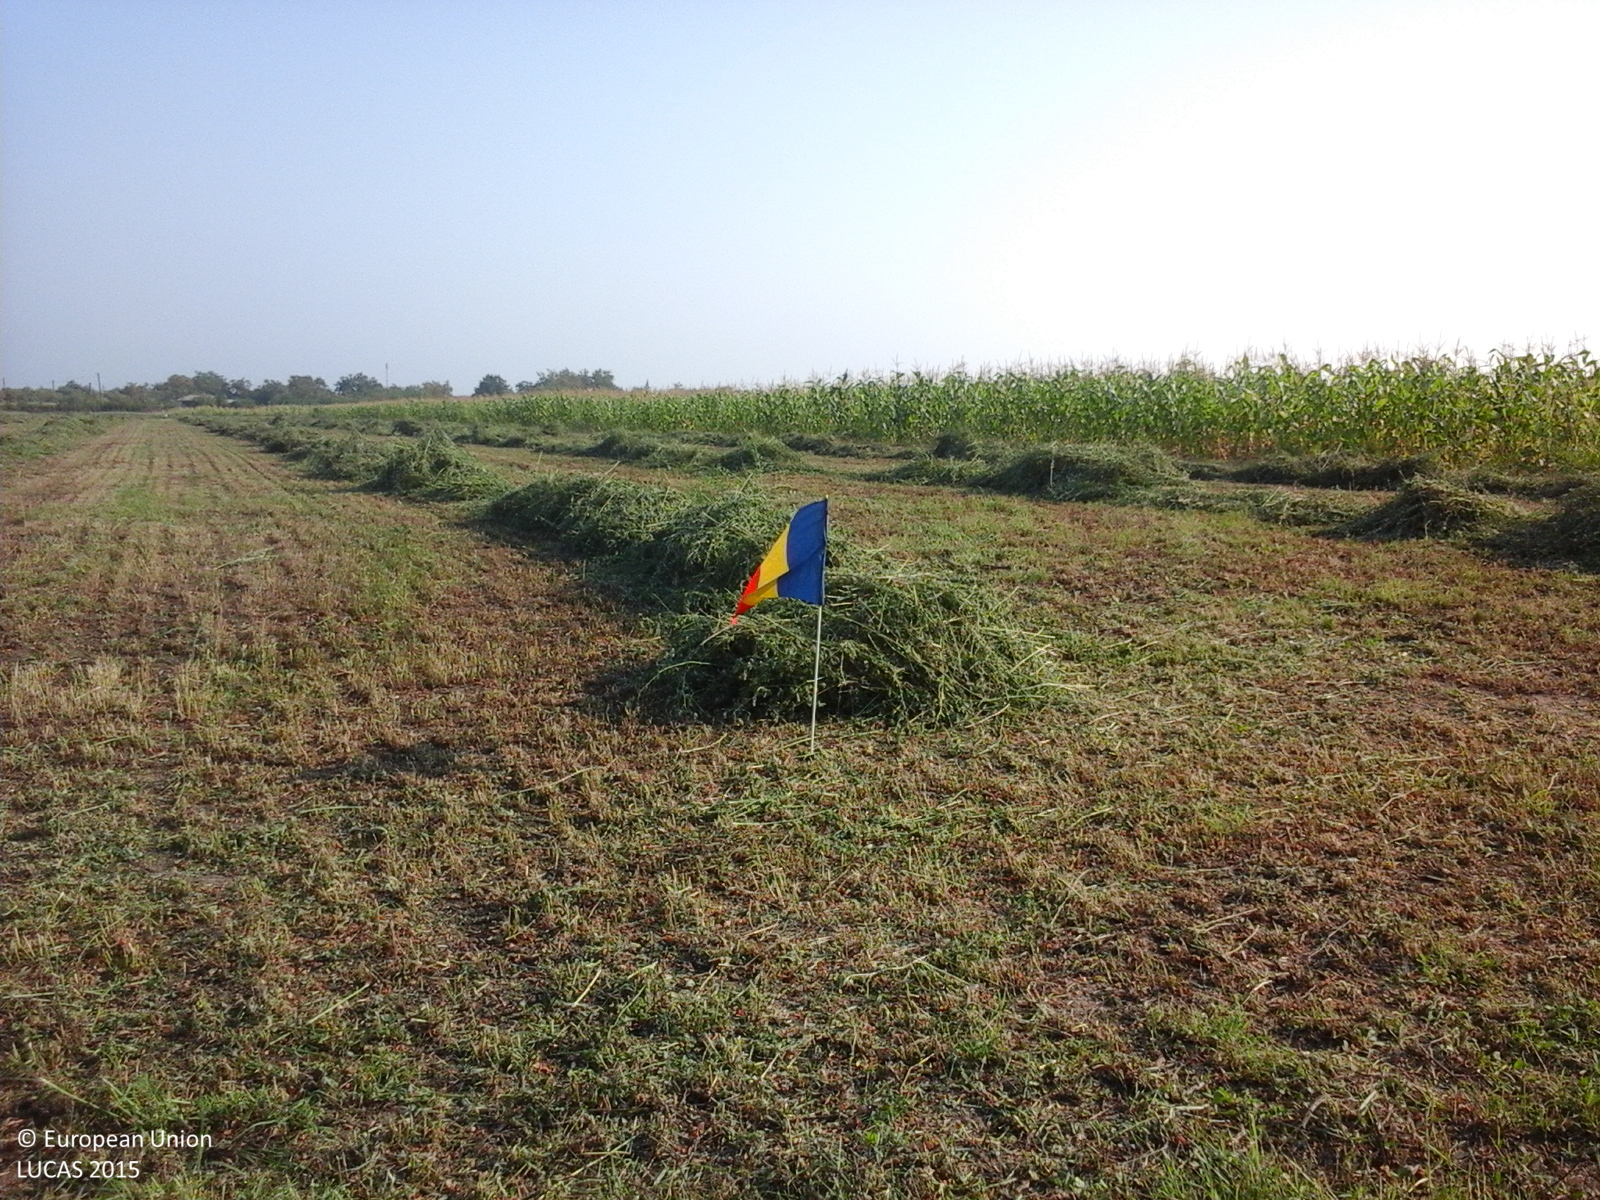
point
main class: Cropland
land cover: Lucerne
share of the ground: 50 - 75 %
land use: Agriculture (excluding fallow land and kitchen gardens)
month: July
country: RO
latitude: 45.5681
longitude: 27.5429
